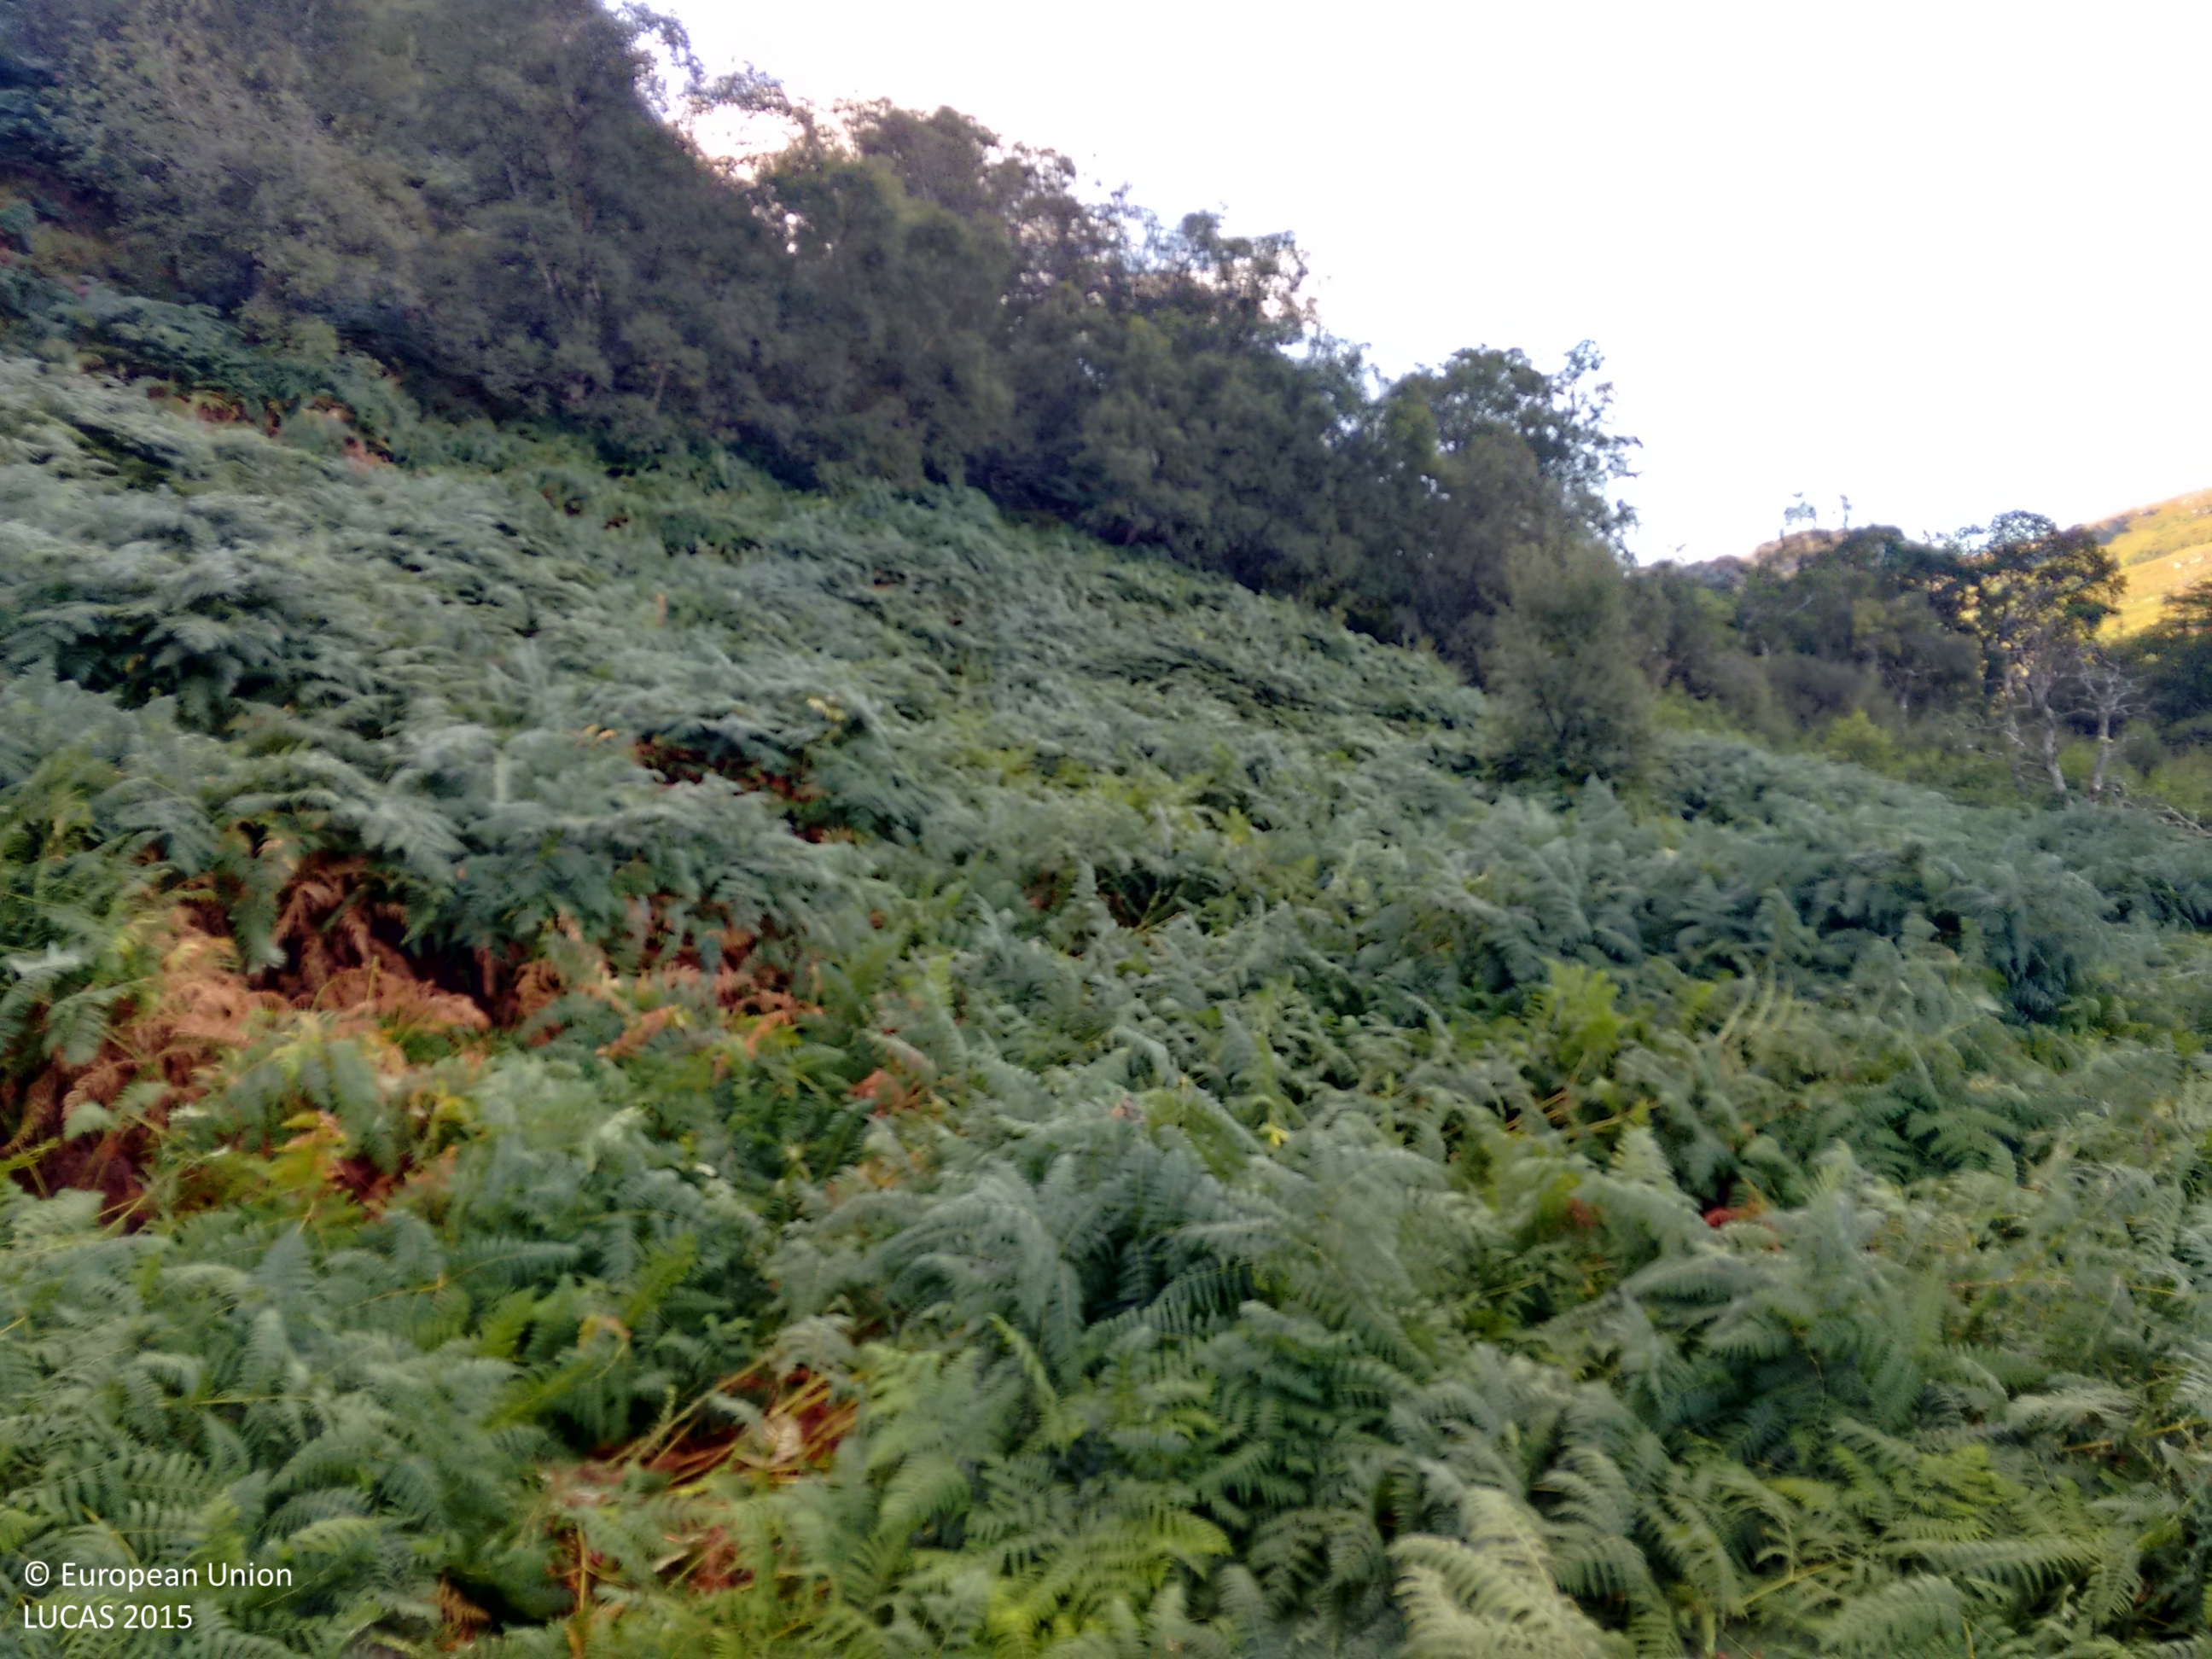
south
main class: Grassland
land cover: Grassland with sparse tree/shrub cover
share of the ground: > 75 %
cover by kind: herbaceous plants 85 %, shrubs 10 %, broadleaved forest trees 5 %
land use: Forestry
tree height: > 5 m
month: September
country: GB
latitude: 57.8275
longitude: -5.1753
